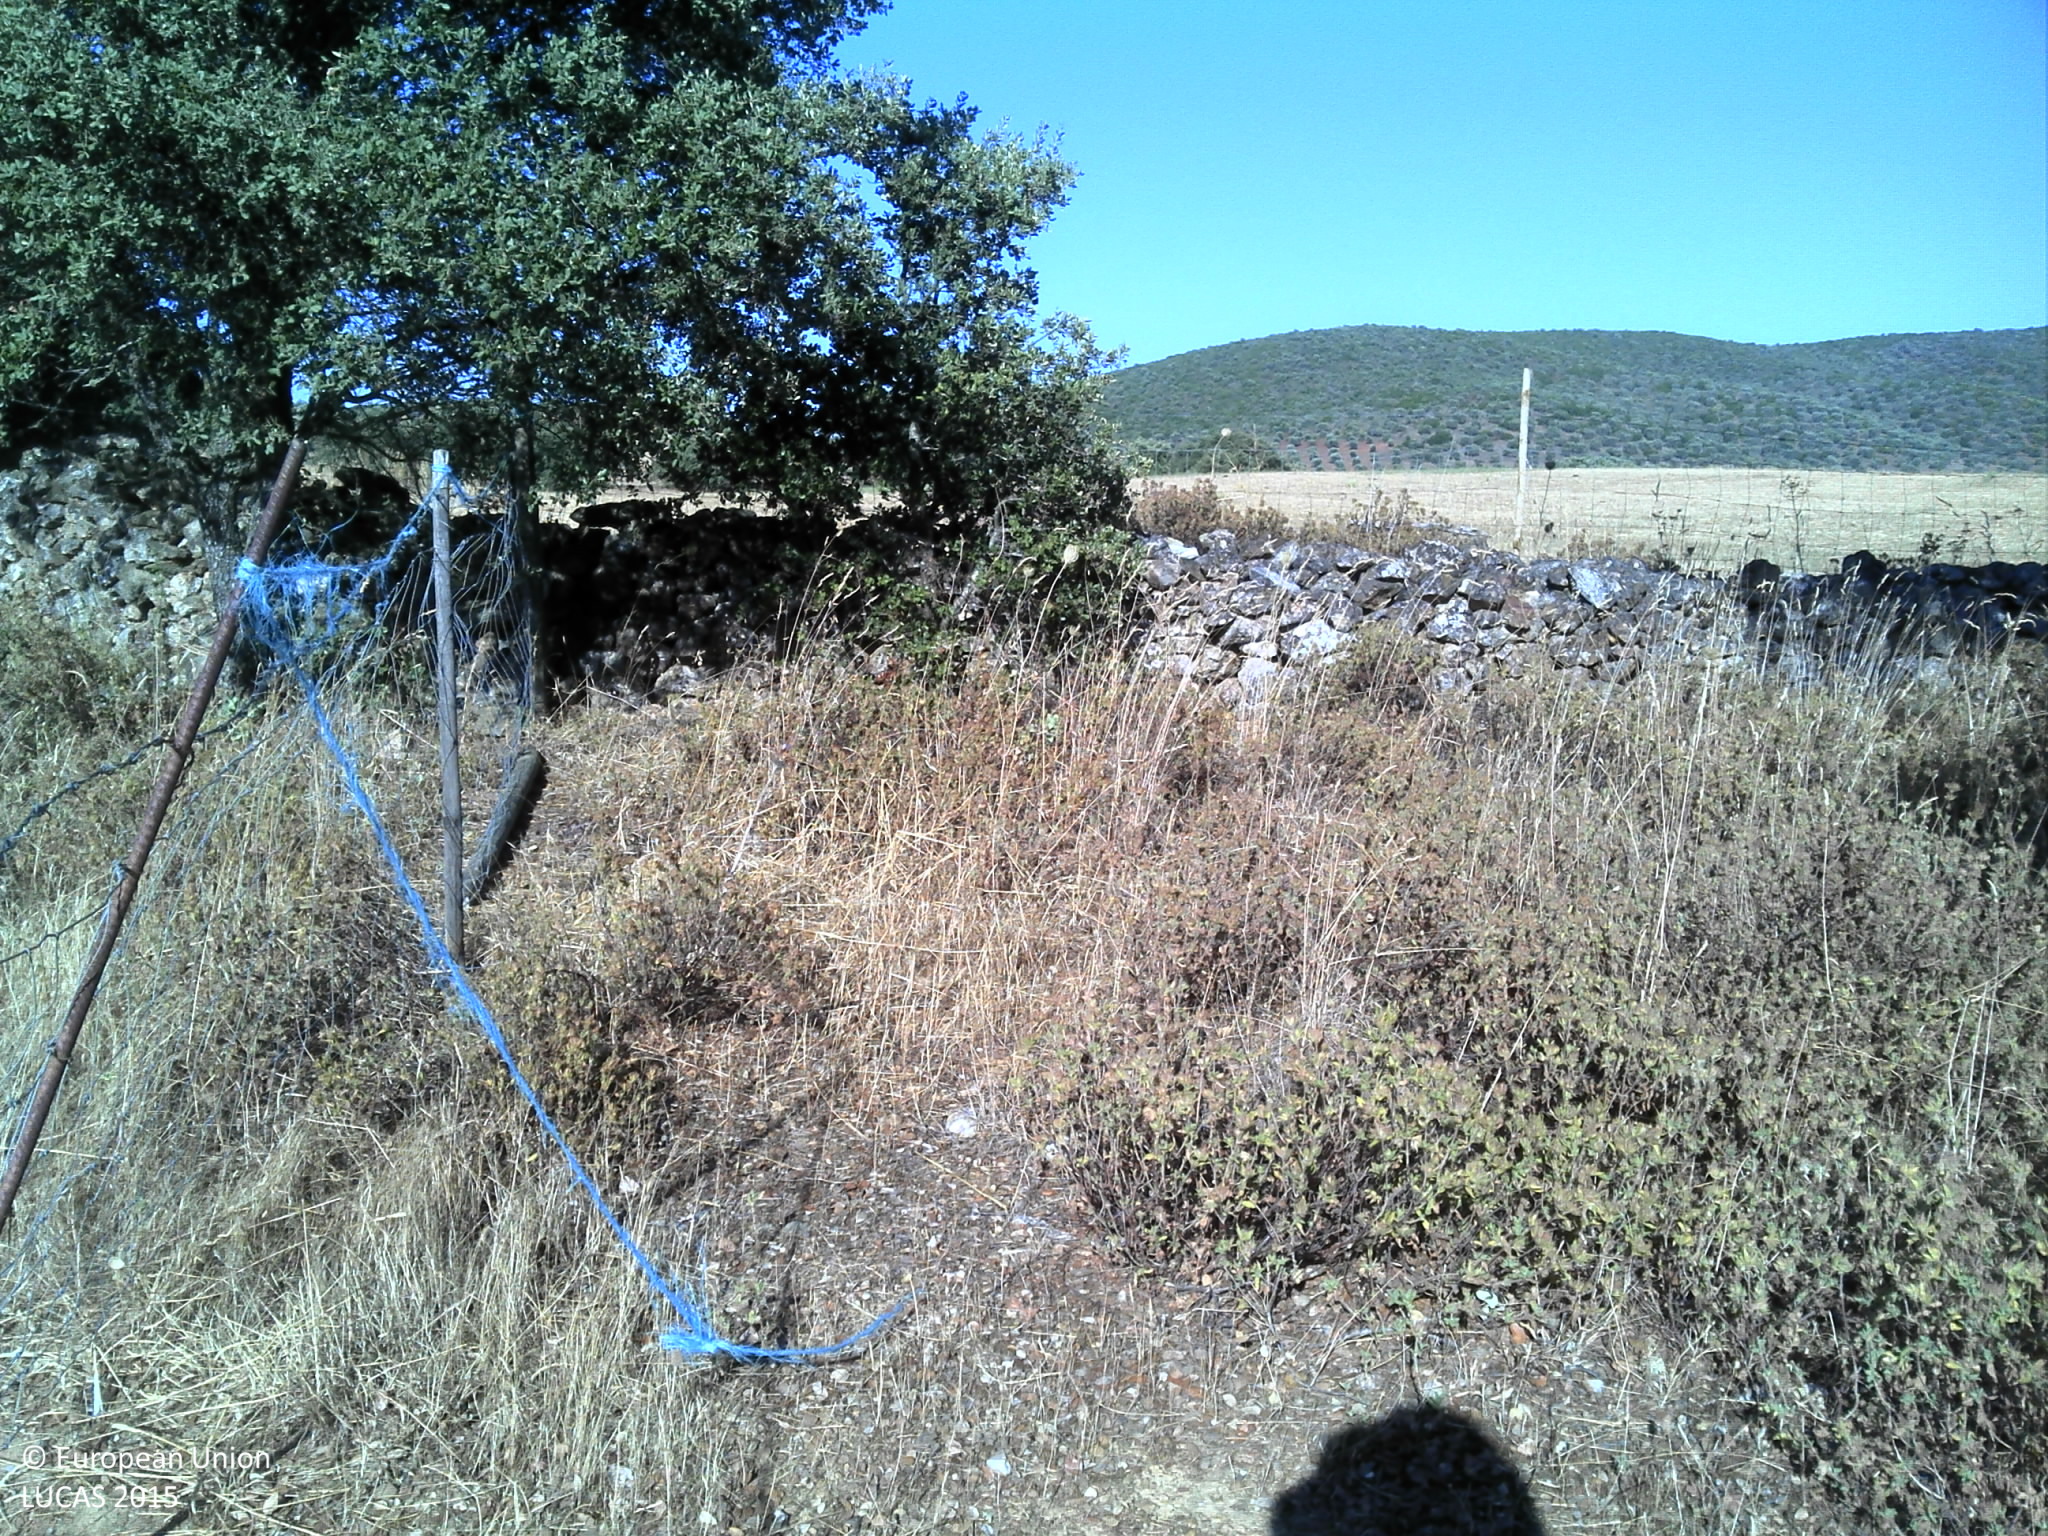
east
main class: Grassland
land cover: Grassland without tree/shrub cover
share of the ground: > 75 %
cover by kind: herbaceous plants 100 %
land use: Agriculture (excluding fallow land and kitchen gardens)
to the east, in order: Grassland without tree/shrub cover; Rivers and streams; Grassland without tree/shrub cover; Broadleaved woodland
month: June
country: PT
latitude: 37.9773
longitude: -7.3075
